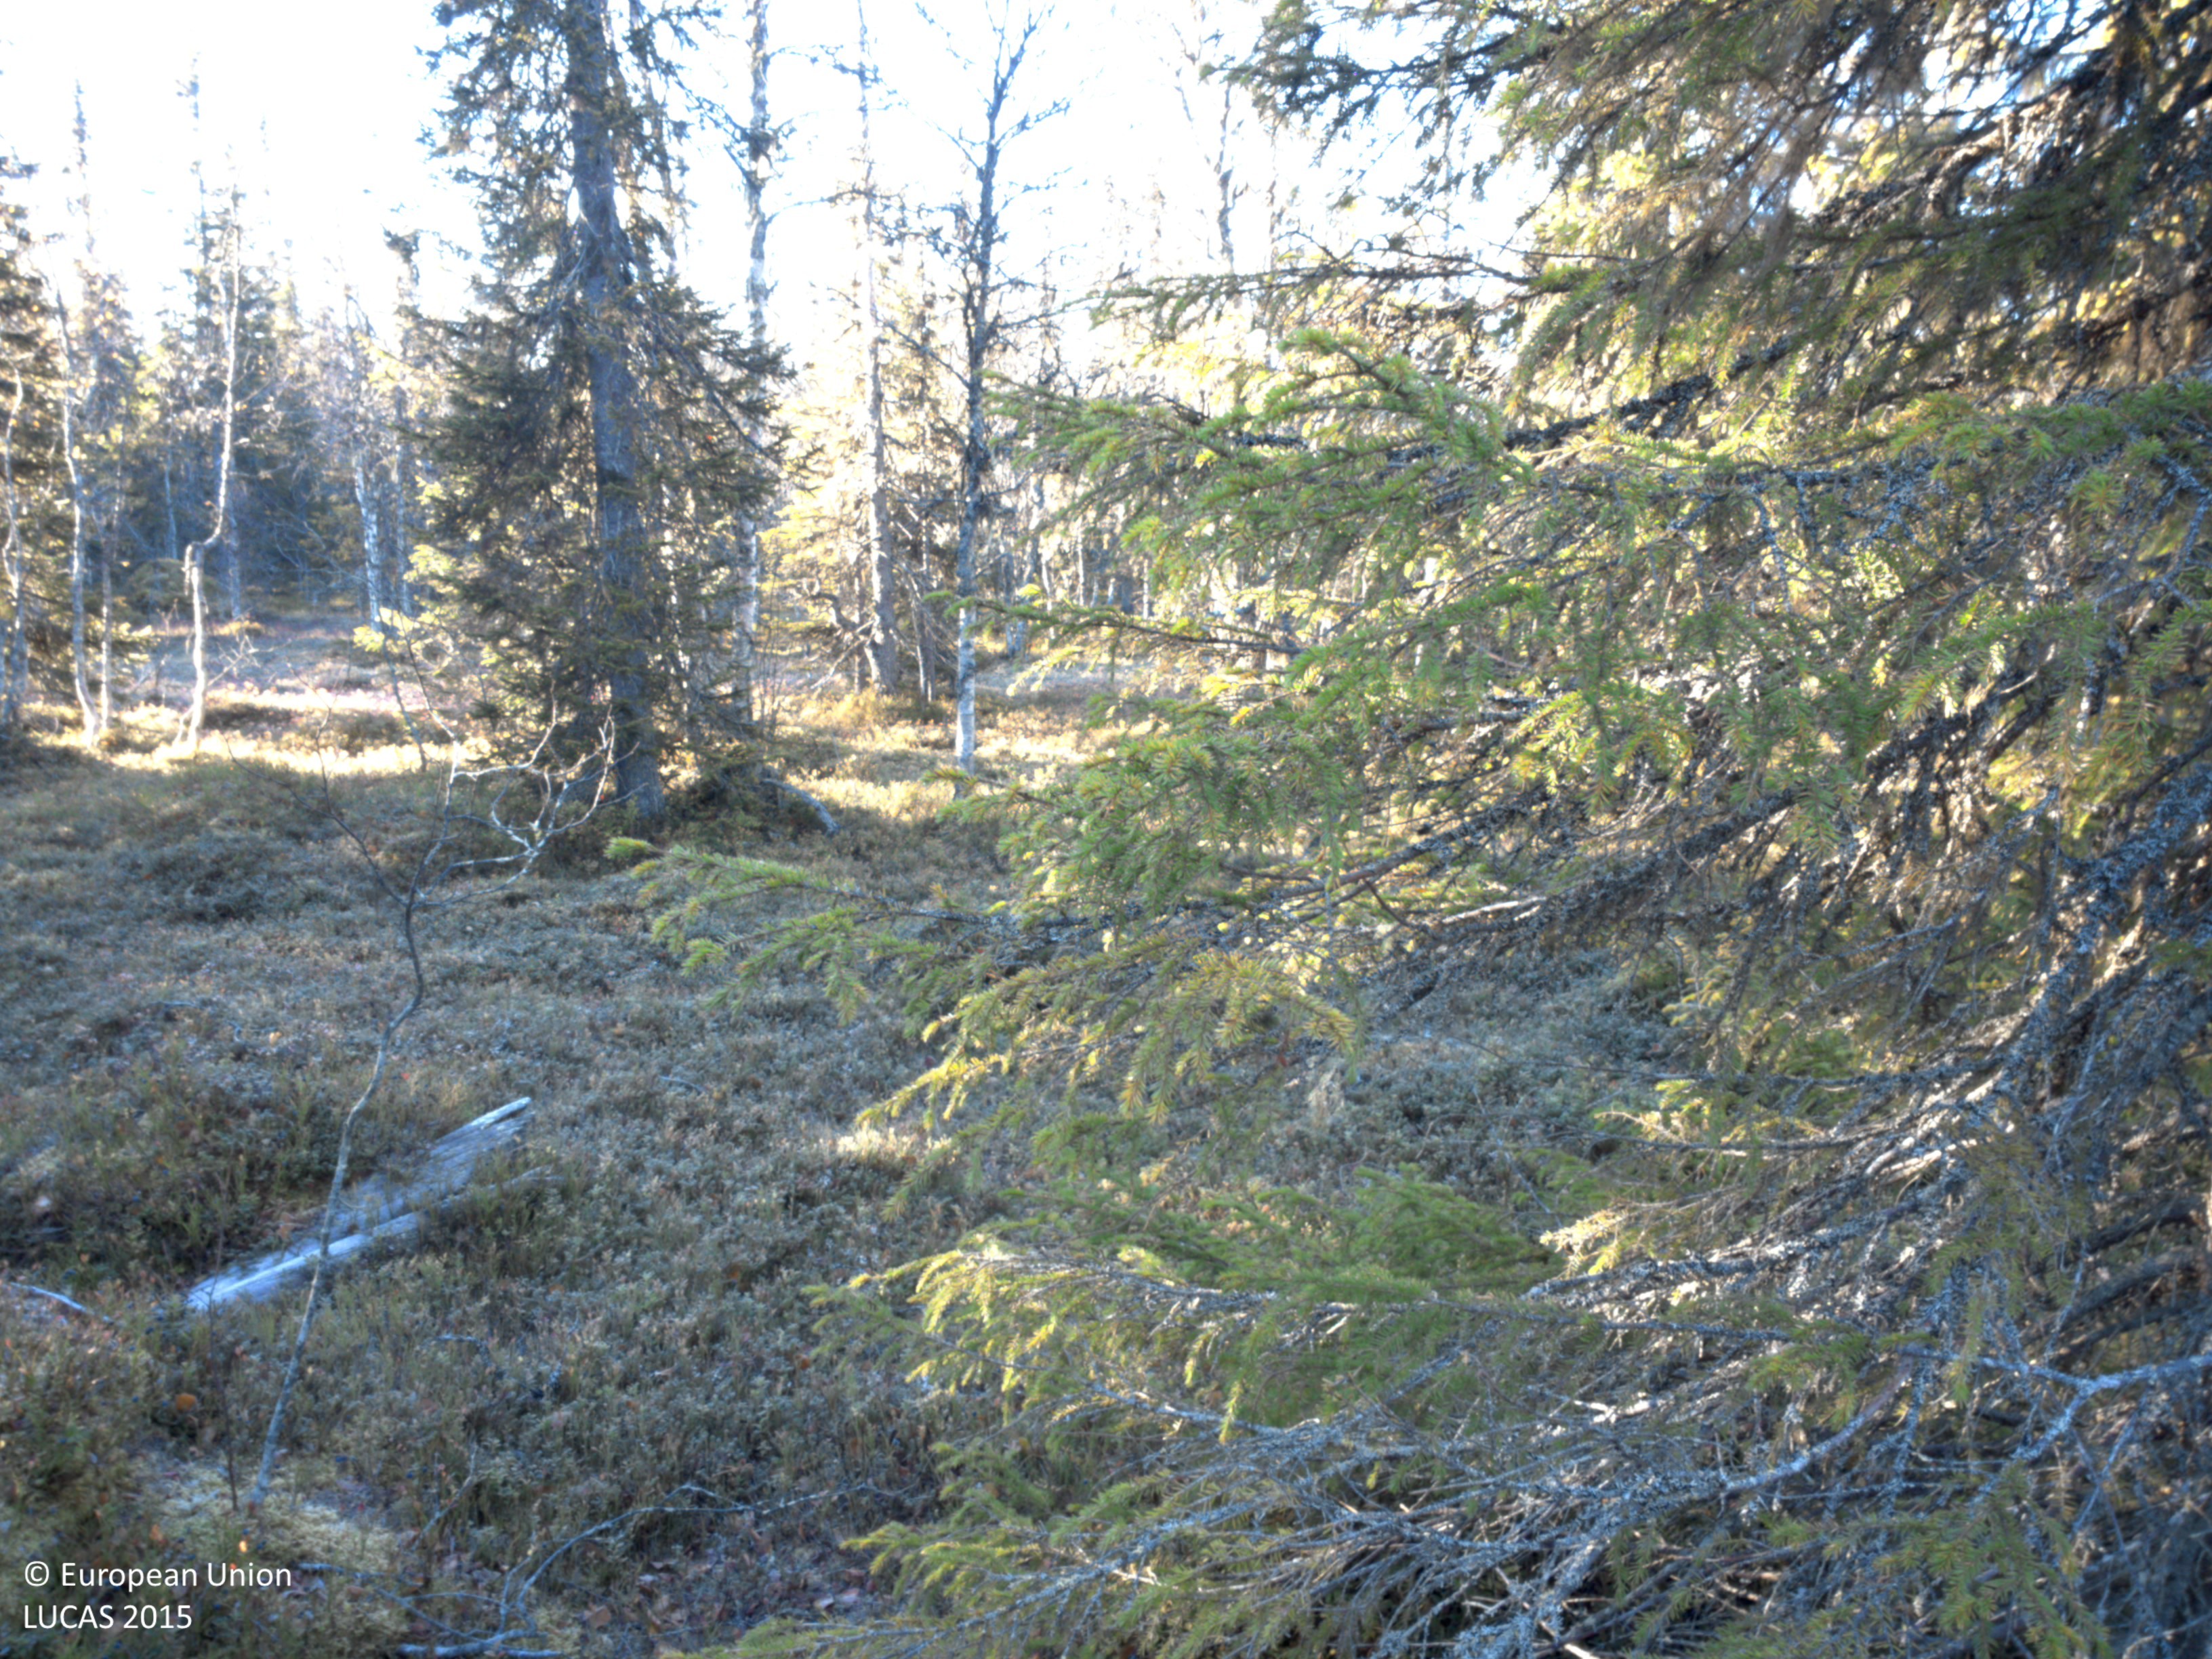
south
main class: Woodland
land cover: Spruce dominated mixed woodland
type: boreal forest
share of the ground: 25 - 50 %
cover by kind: coniferous forest trees 35 %, shrubs 30 %, broadleaved forest trees 15 %, lichens and mosses 15 %, herbaceous plants 5 %
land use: Forestry
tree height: > 5 m
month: October
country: SE
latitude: 64.5518
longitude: 17.7887
